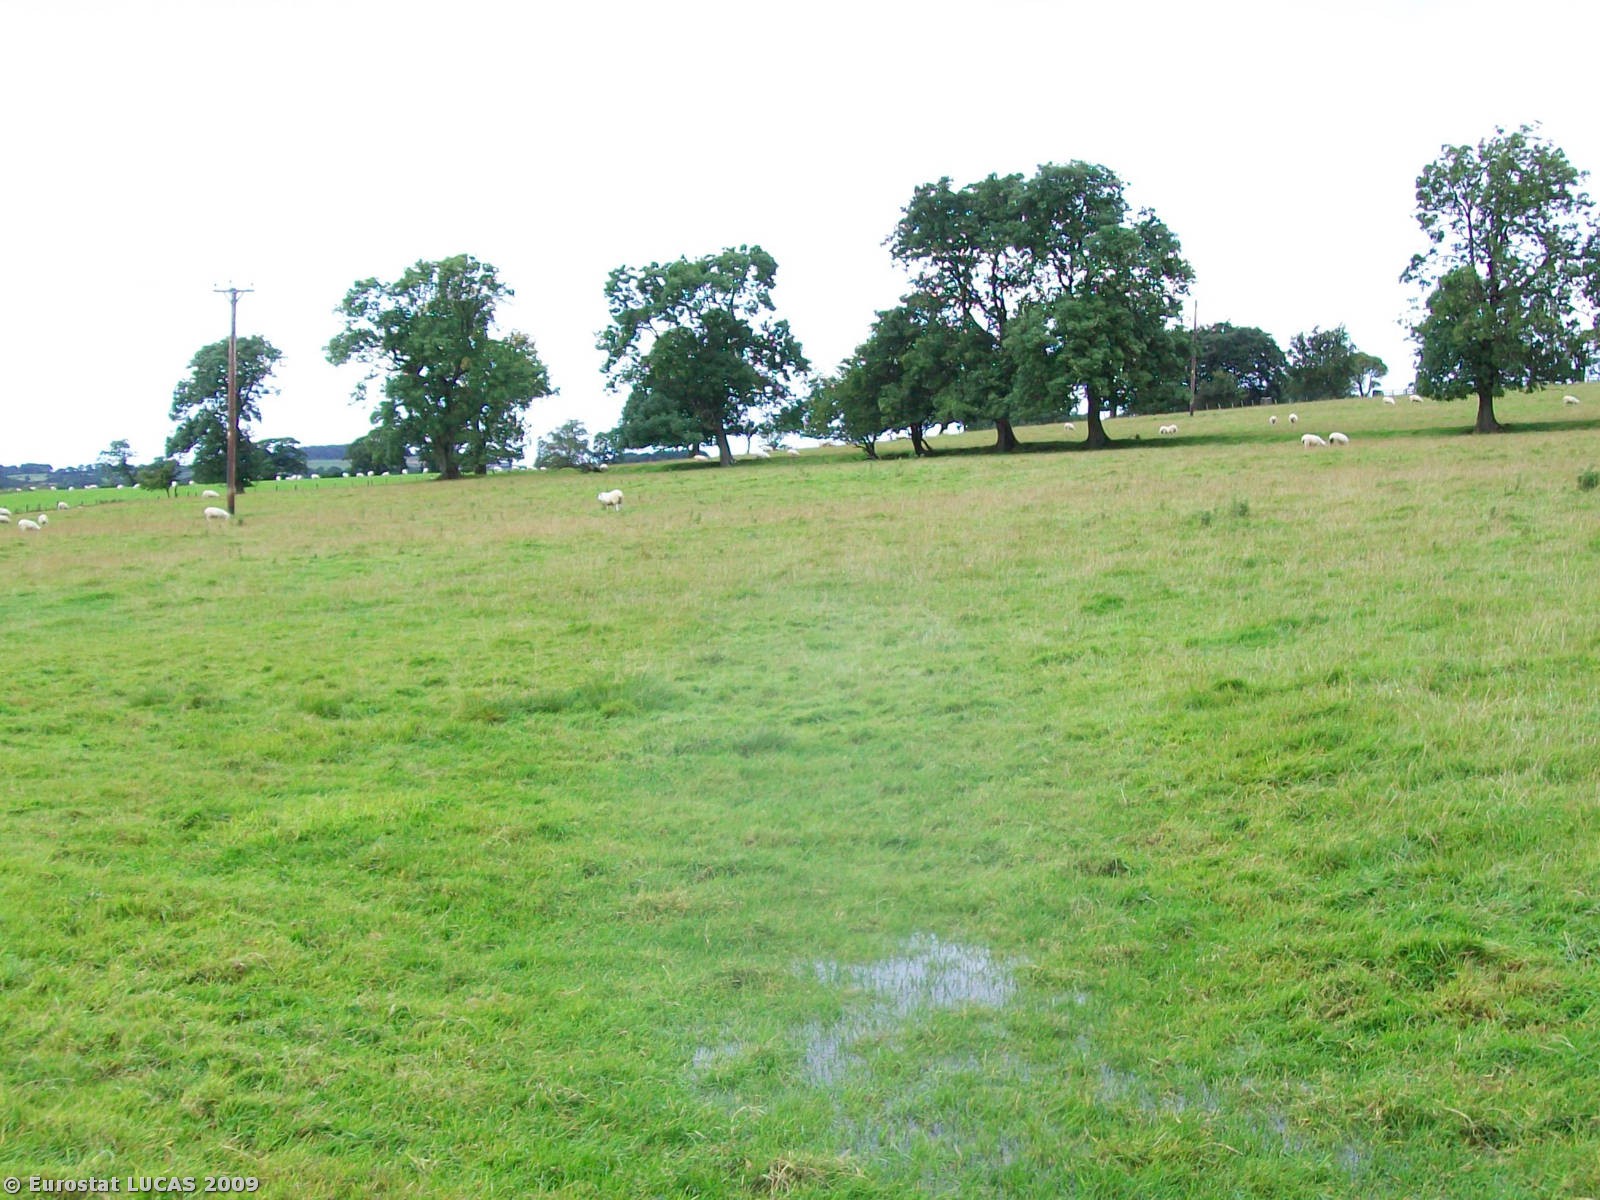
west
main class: Grassland
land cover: Grassland without tree/shrub cover
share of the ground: > 75 %
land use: Agriculture (excluding fallow land and kitchen gardens)
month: September
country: GB
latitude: 55.0228
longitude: -1.9891
